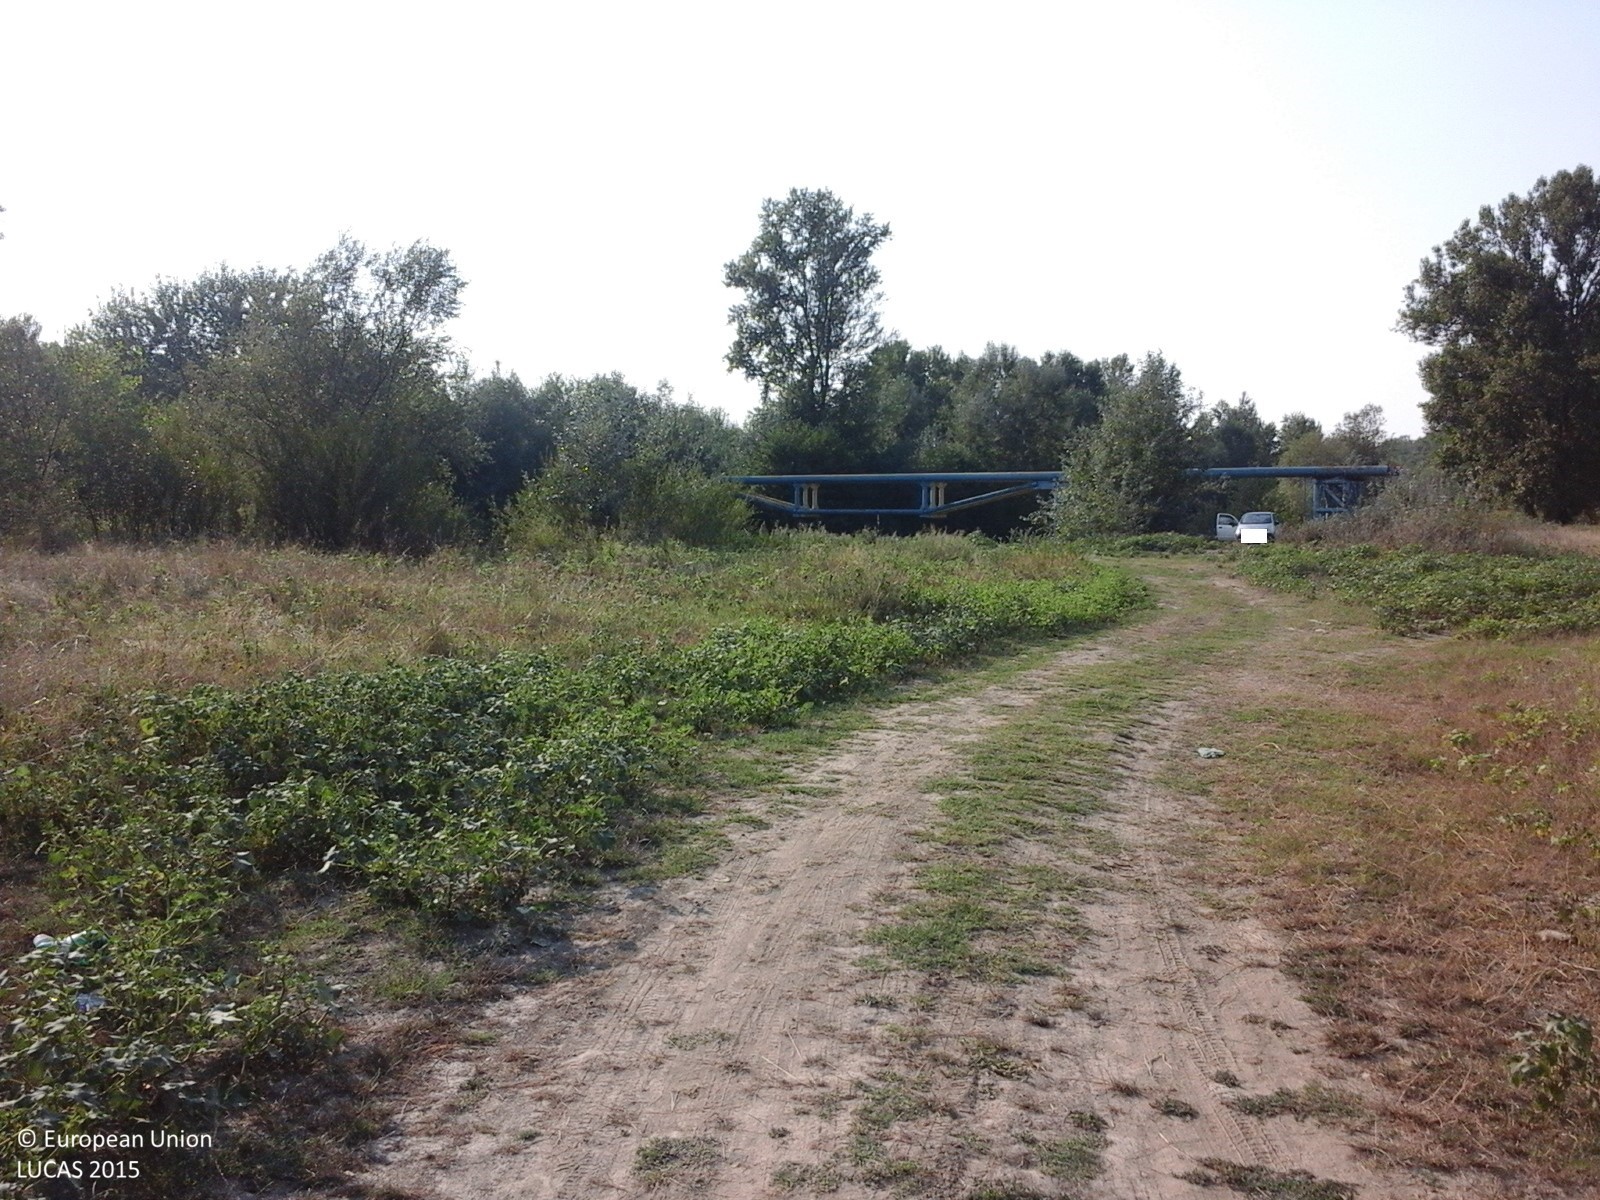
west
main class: Grassland
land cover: Spontaneously vegetated surfaces
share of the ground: > 75 %
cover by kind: herbaceous plants 100 %
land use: Fallow land
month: August
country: RO
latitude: 44.4919
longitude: 23.5984
